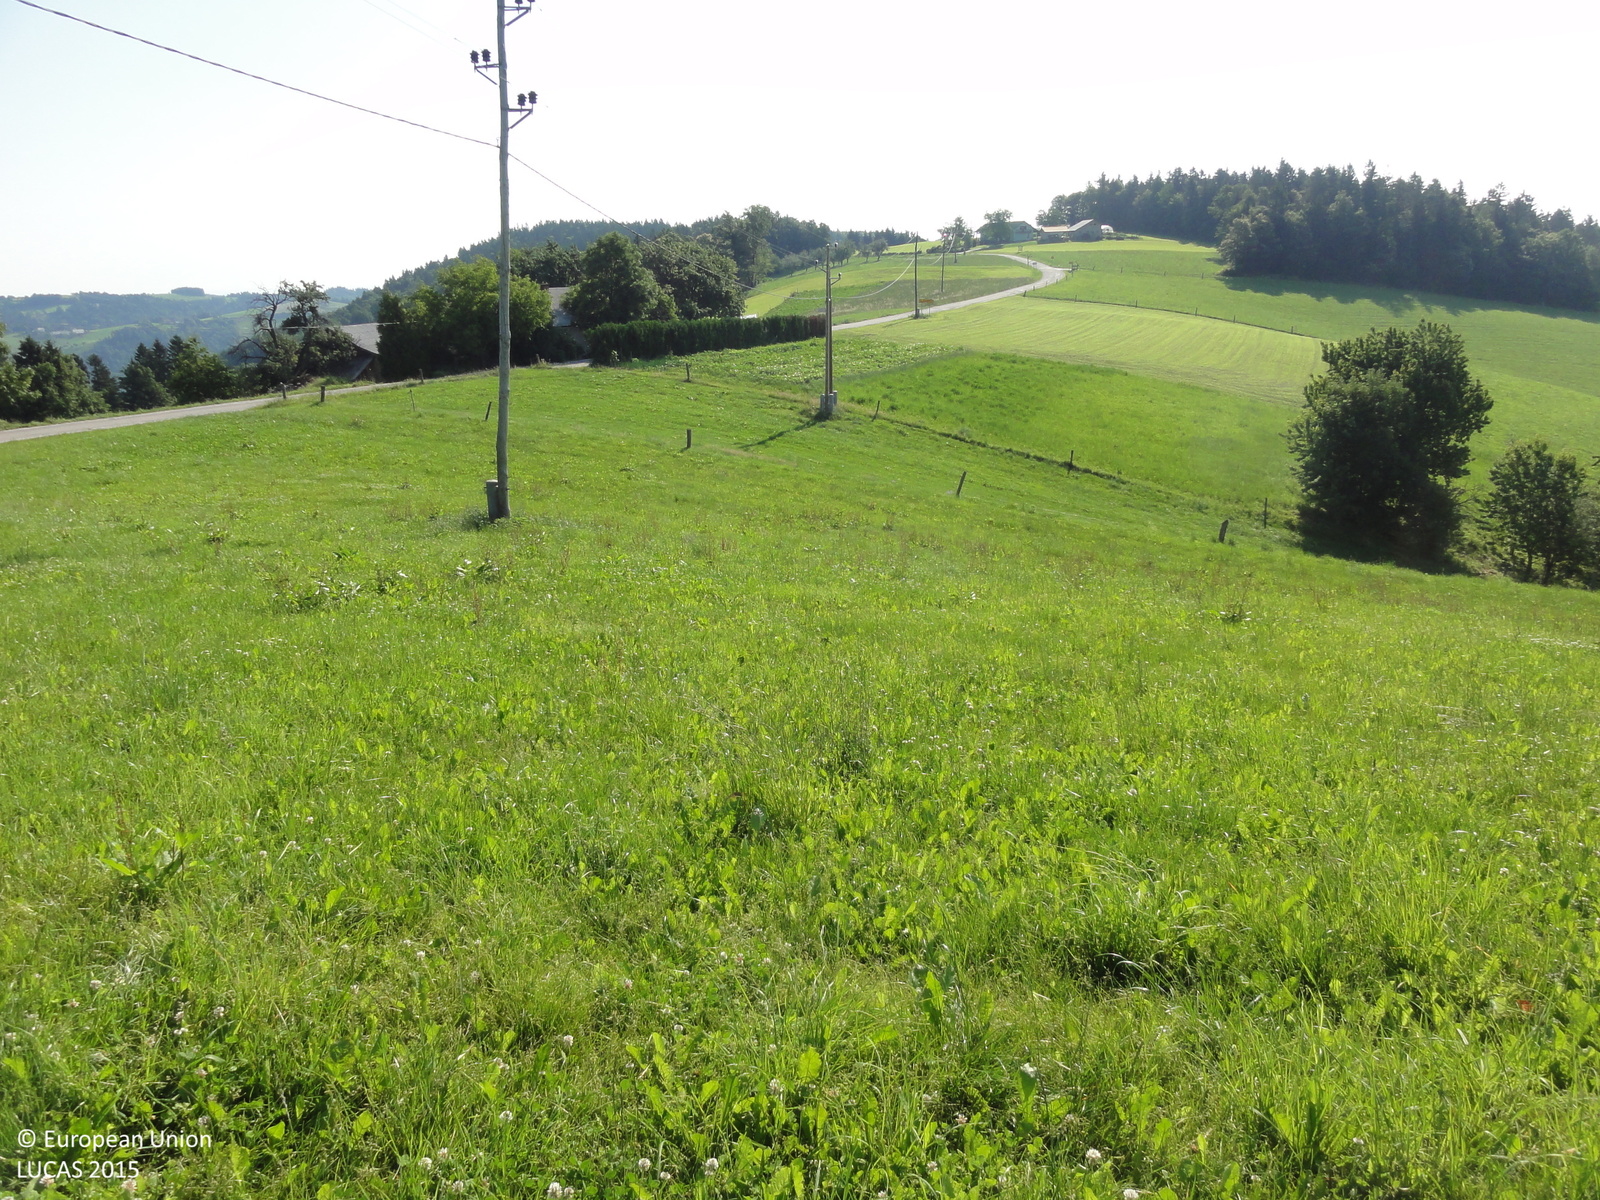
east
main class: Grassland
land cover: Grassland without tree/shrub cover
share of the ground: > 75 %
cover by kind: herbaceous plants 100 %
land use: Agriculture (excluding fallow land and kitchen gardens)
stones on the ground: < 10 %
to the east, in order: Grassland without tree/shrub cover; Fences; Grassland without tree/shrub cover; Fences; Grassland without tree/shrub cover; Potatoes; Grassland without tree/shrub cover; Fences; Grassland without tree/shrub cover
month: July
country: SI
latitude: 46.4415
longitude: 15.5566
